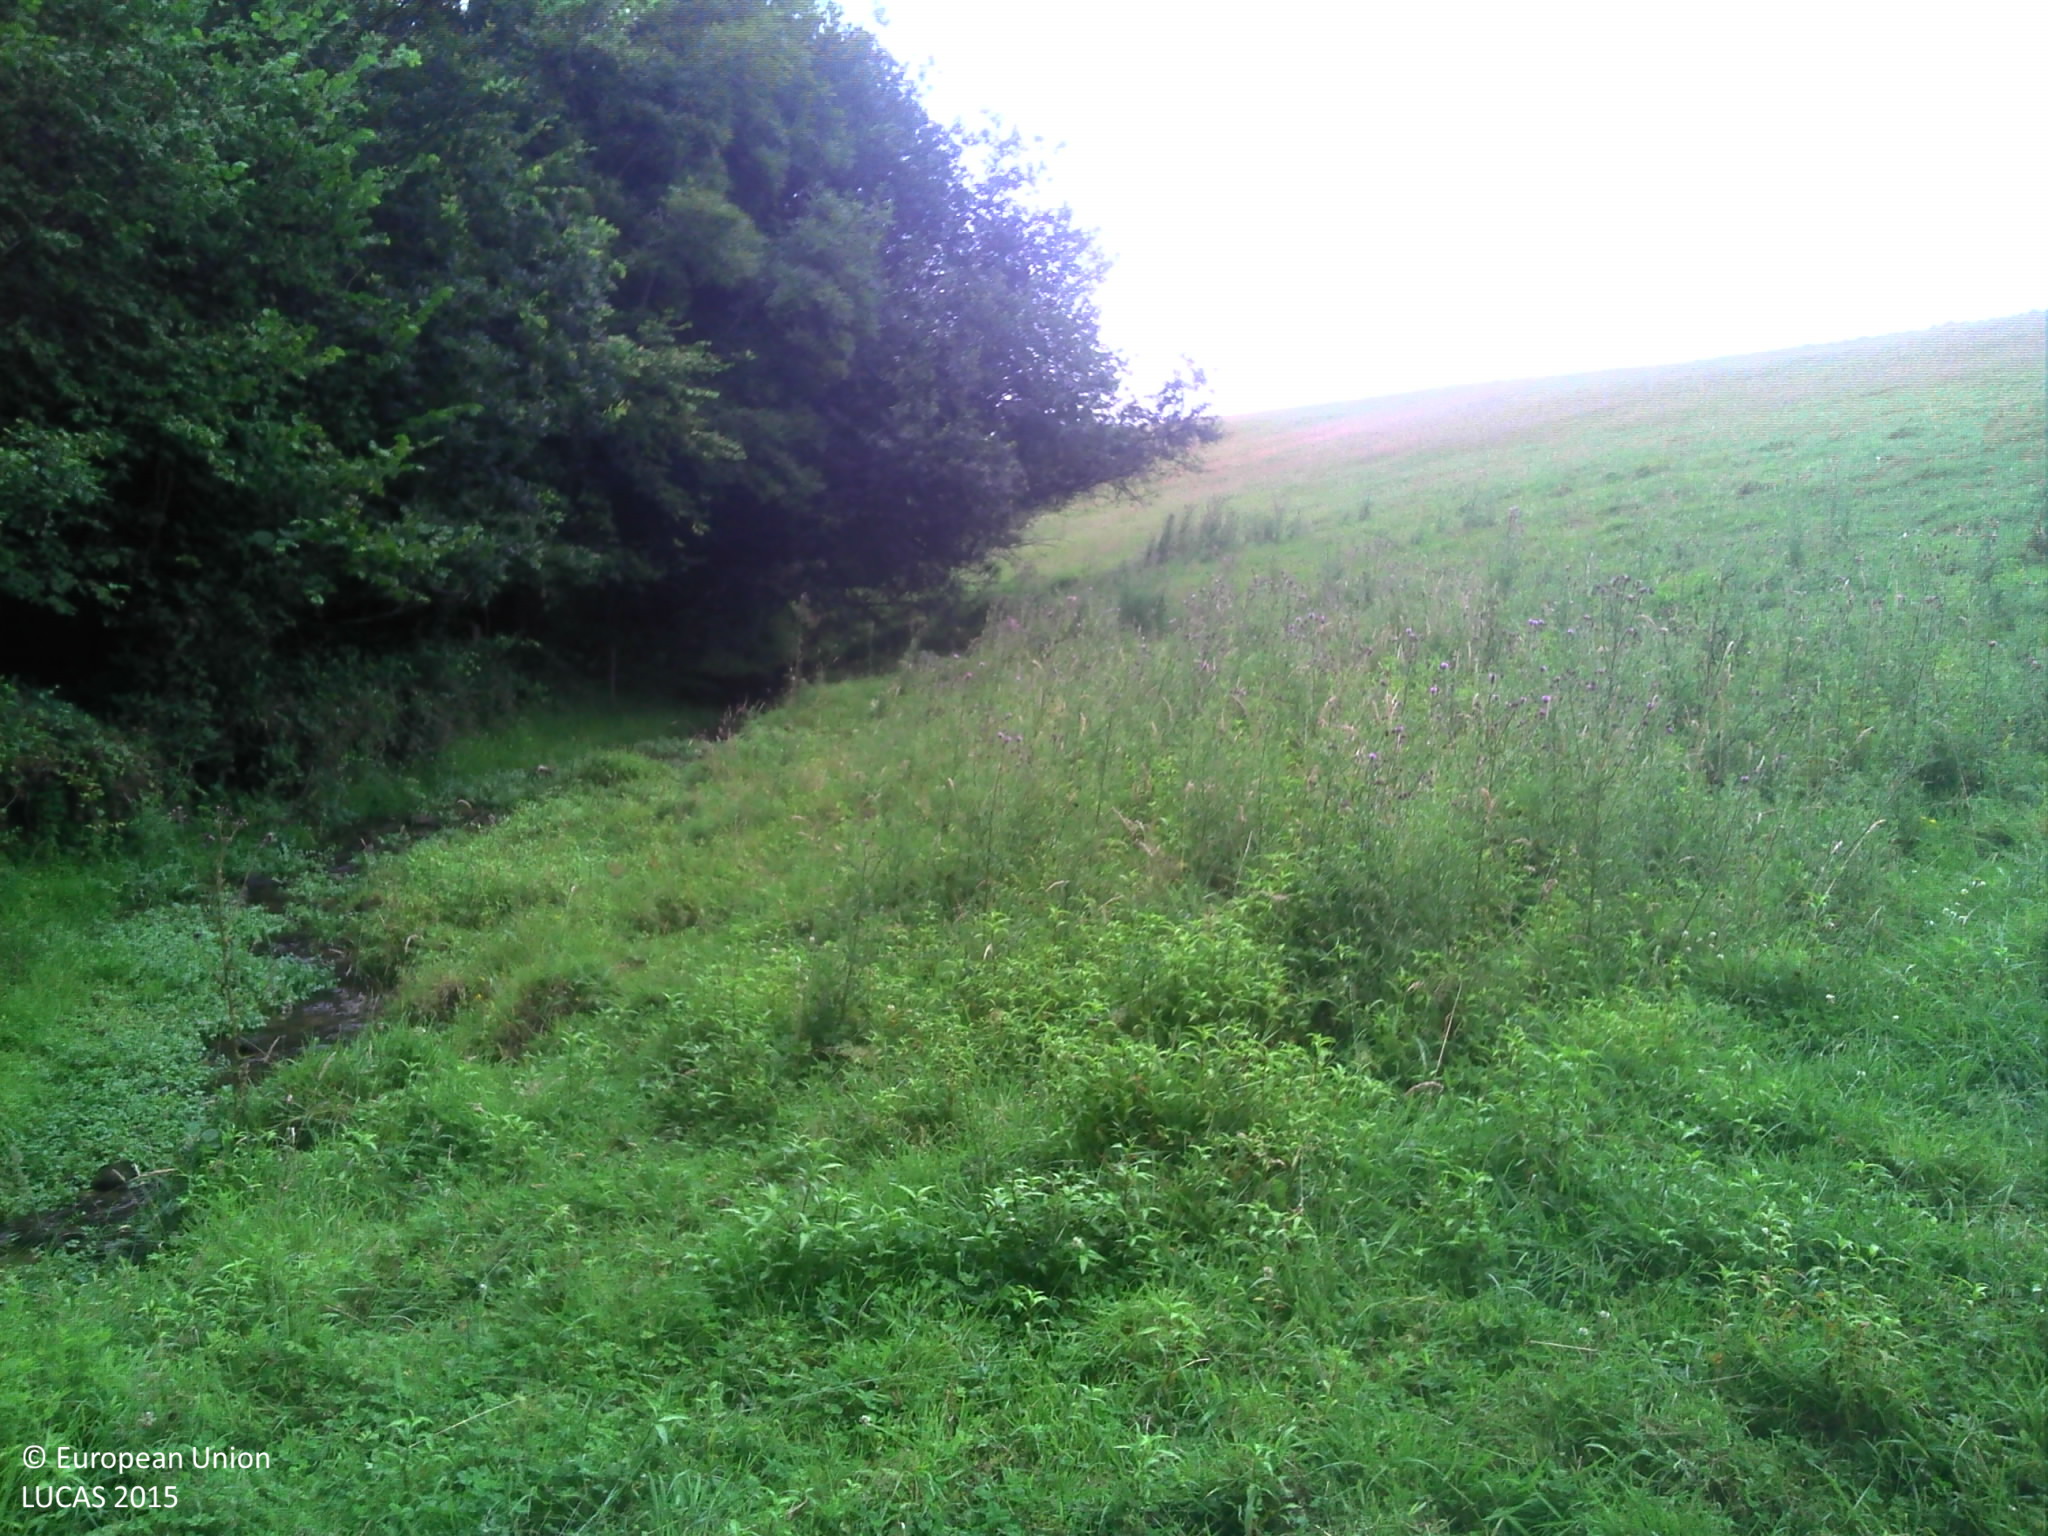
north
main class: Grassland
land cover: Grassland without tree/shrub cover
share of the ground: > 75 %
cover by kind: herbaceous plants 100 %
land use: Agriculture (excluding fallow land and kitchen gardens)
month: July
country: FR
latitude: 48.7589
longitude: -1.3776
